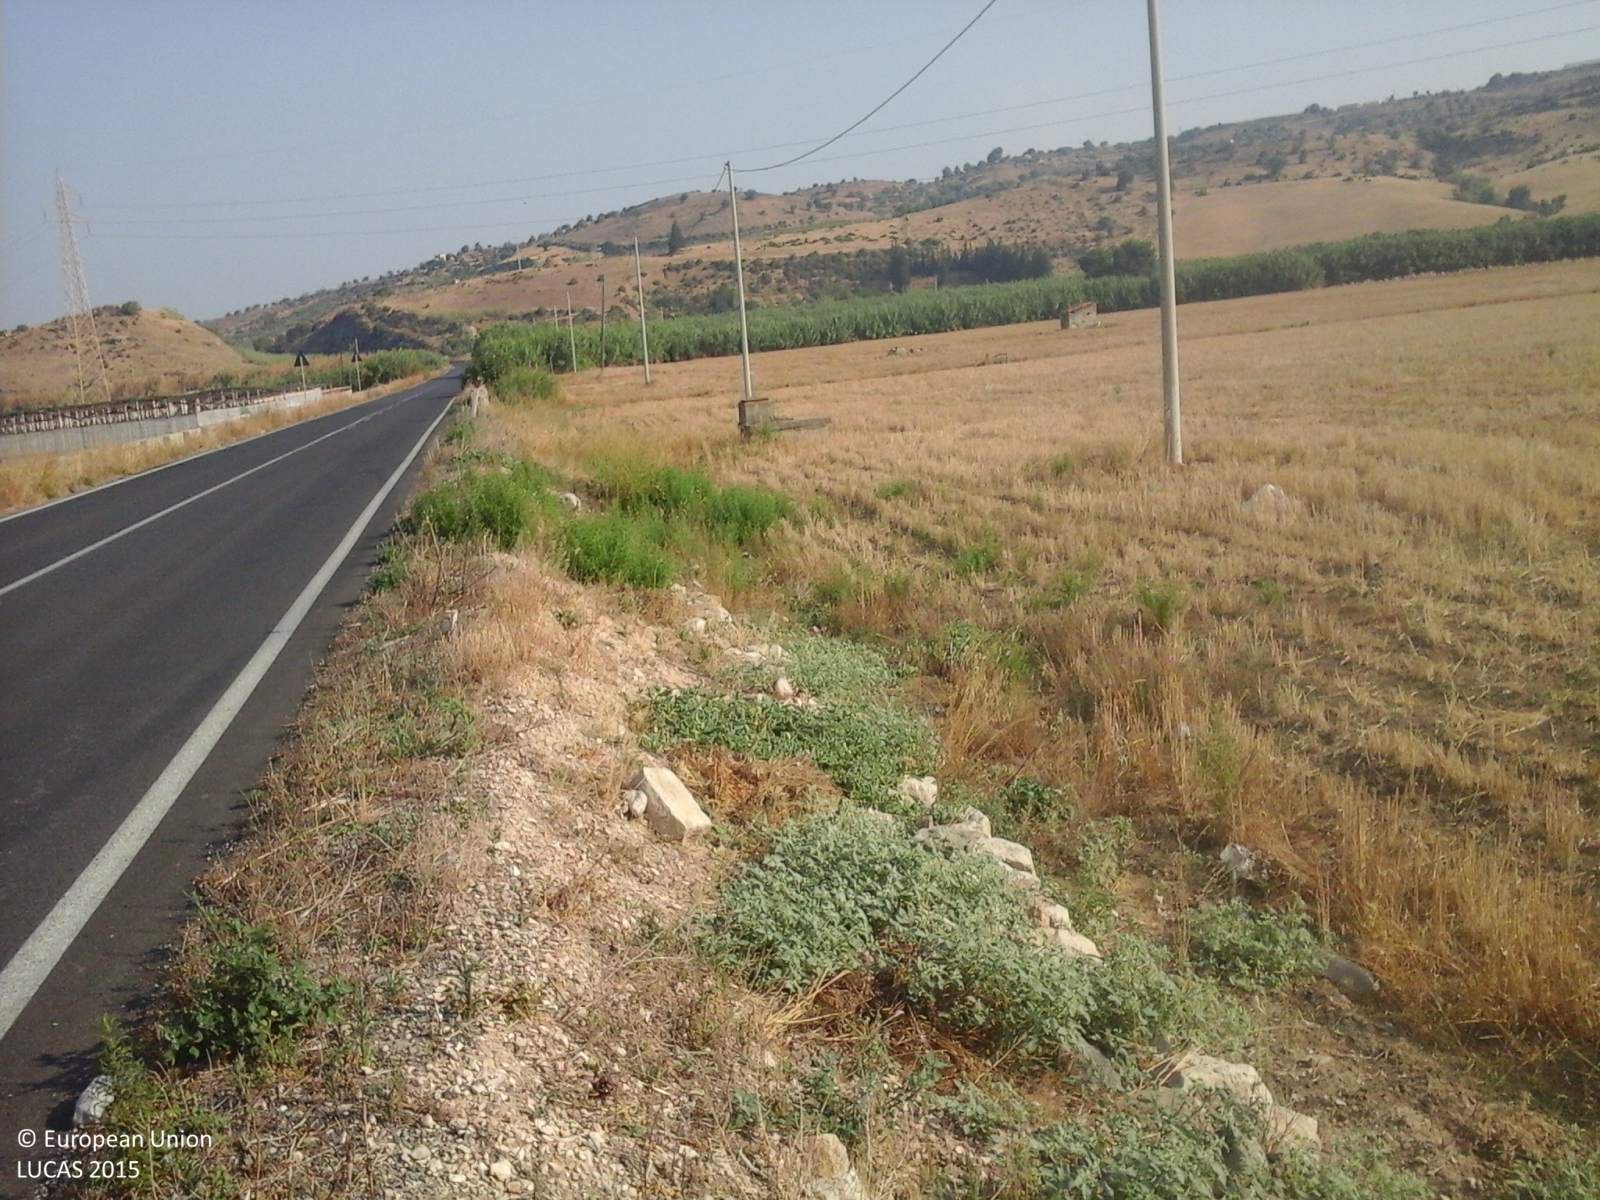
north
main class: Cropland
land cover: Durum wheat
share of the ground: > 75 %
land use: Agriculture (excluding fallow land and kitchen gardens)
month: July
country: IT
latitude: 37.0272
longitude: 14.4053
